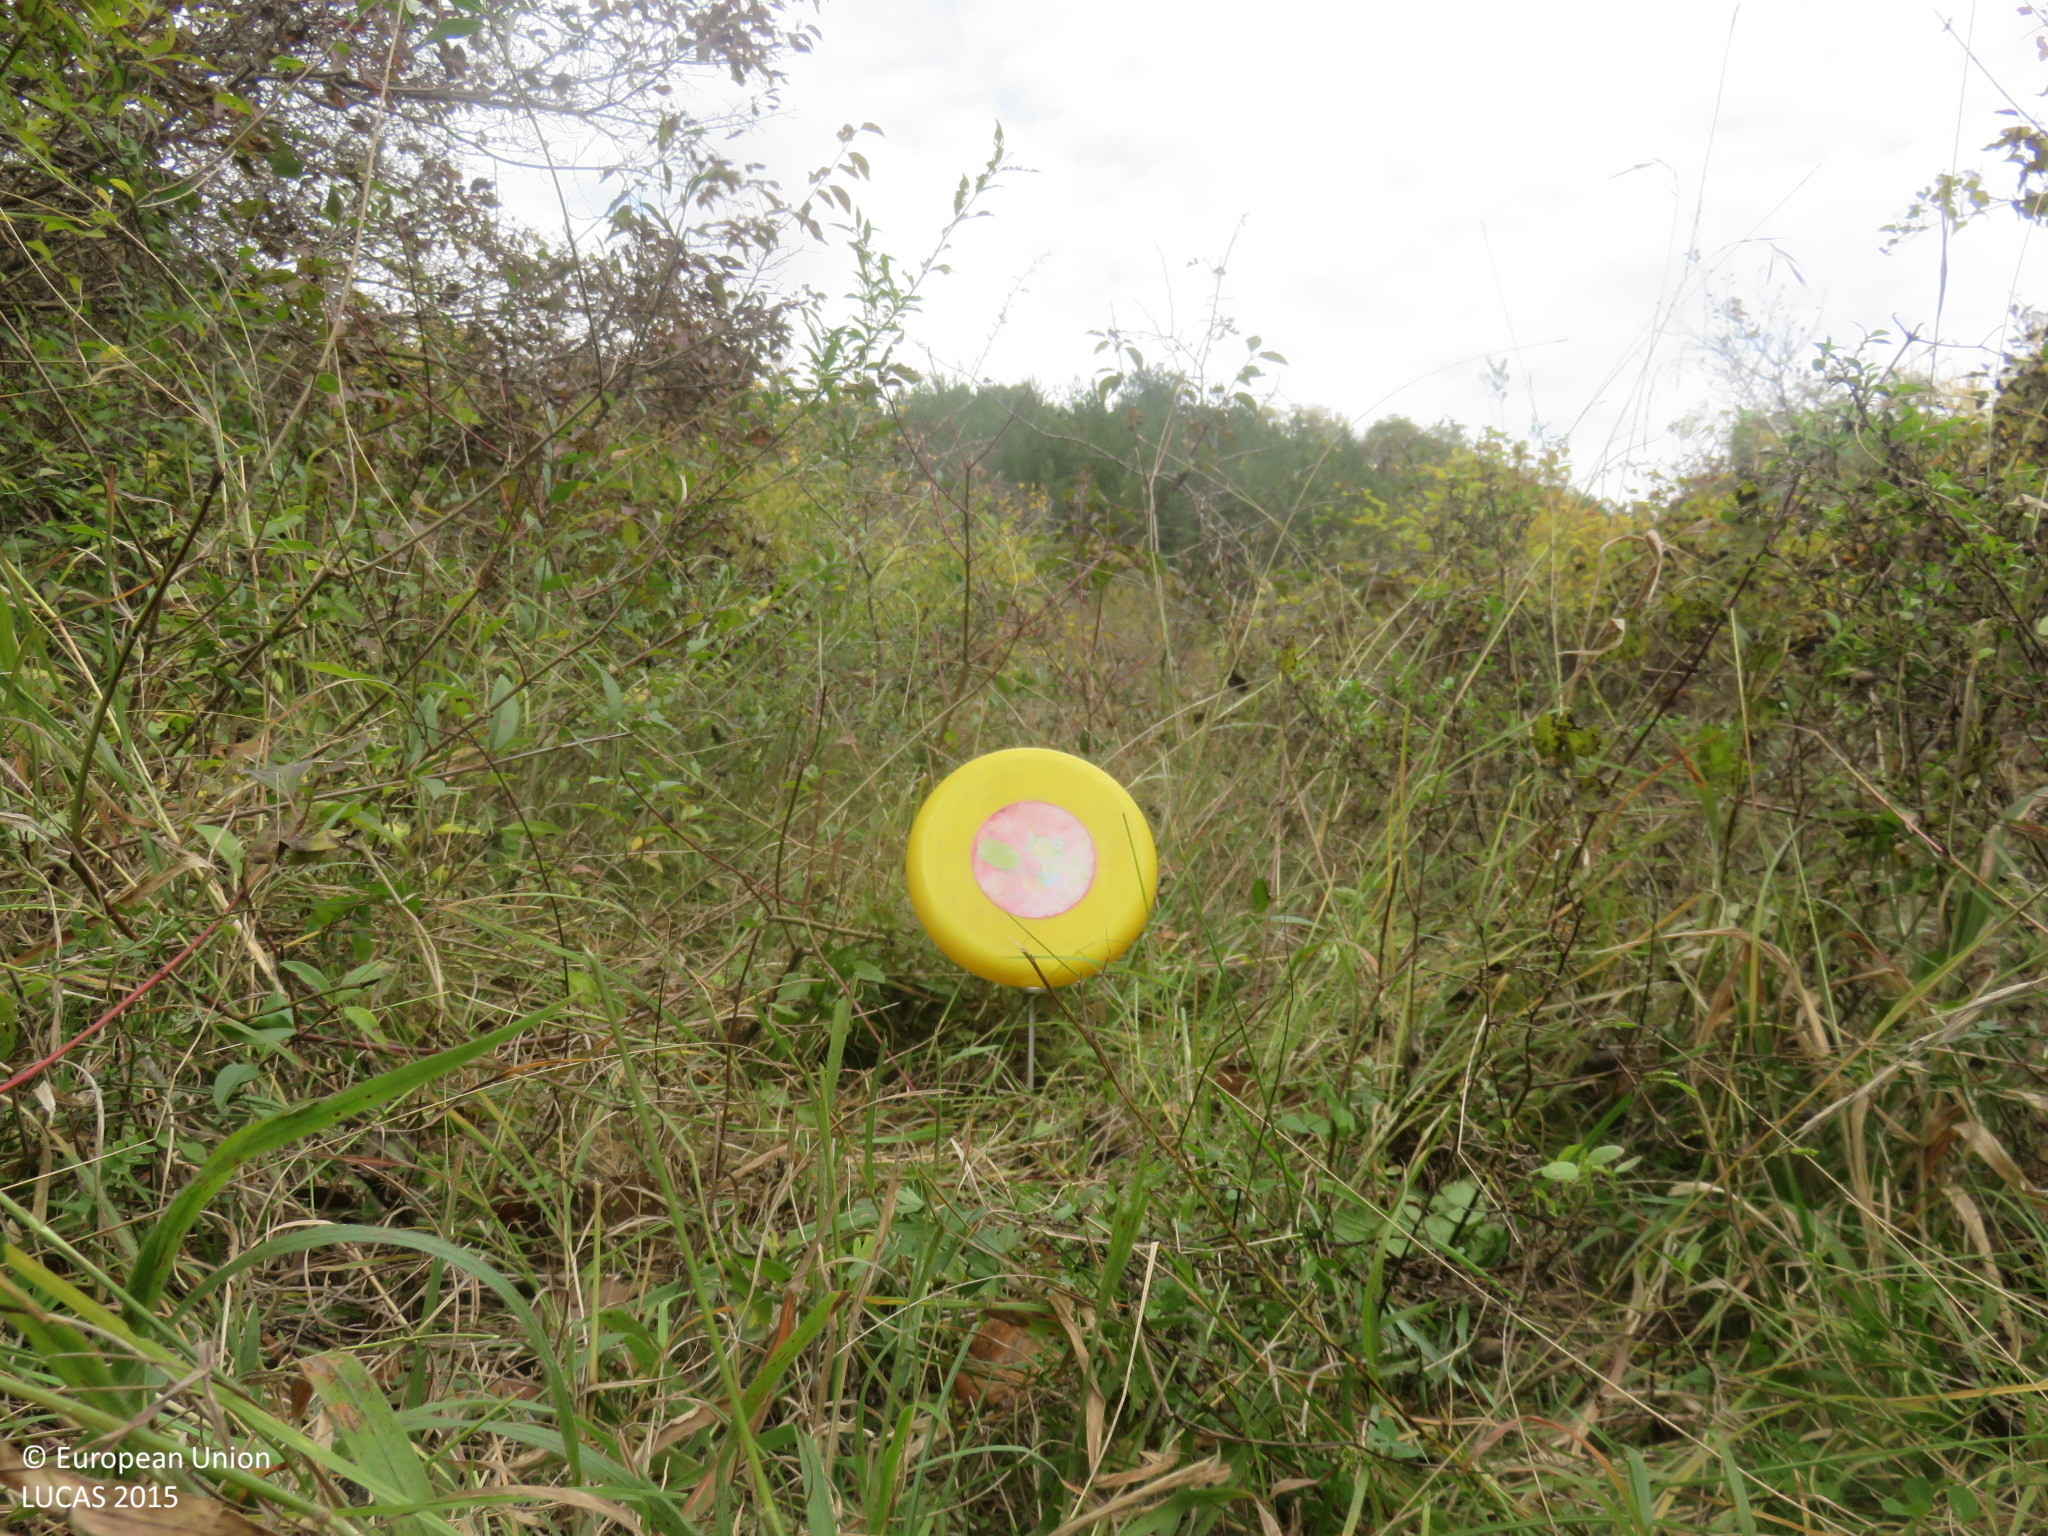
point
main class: Shrubland
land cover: Shrubland with sparse tree cover
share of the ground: > 75 %
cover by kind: shrubs 85 %, herbaceous plants 10 %, broadleaved forest trees 5 %
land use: Semi-natural and natural areas not in use
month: October
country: BG
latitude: 42.9973
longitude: 24.9936
